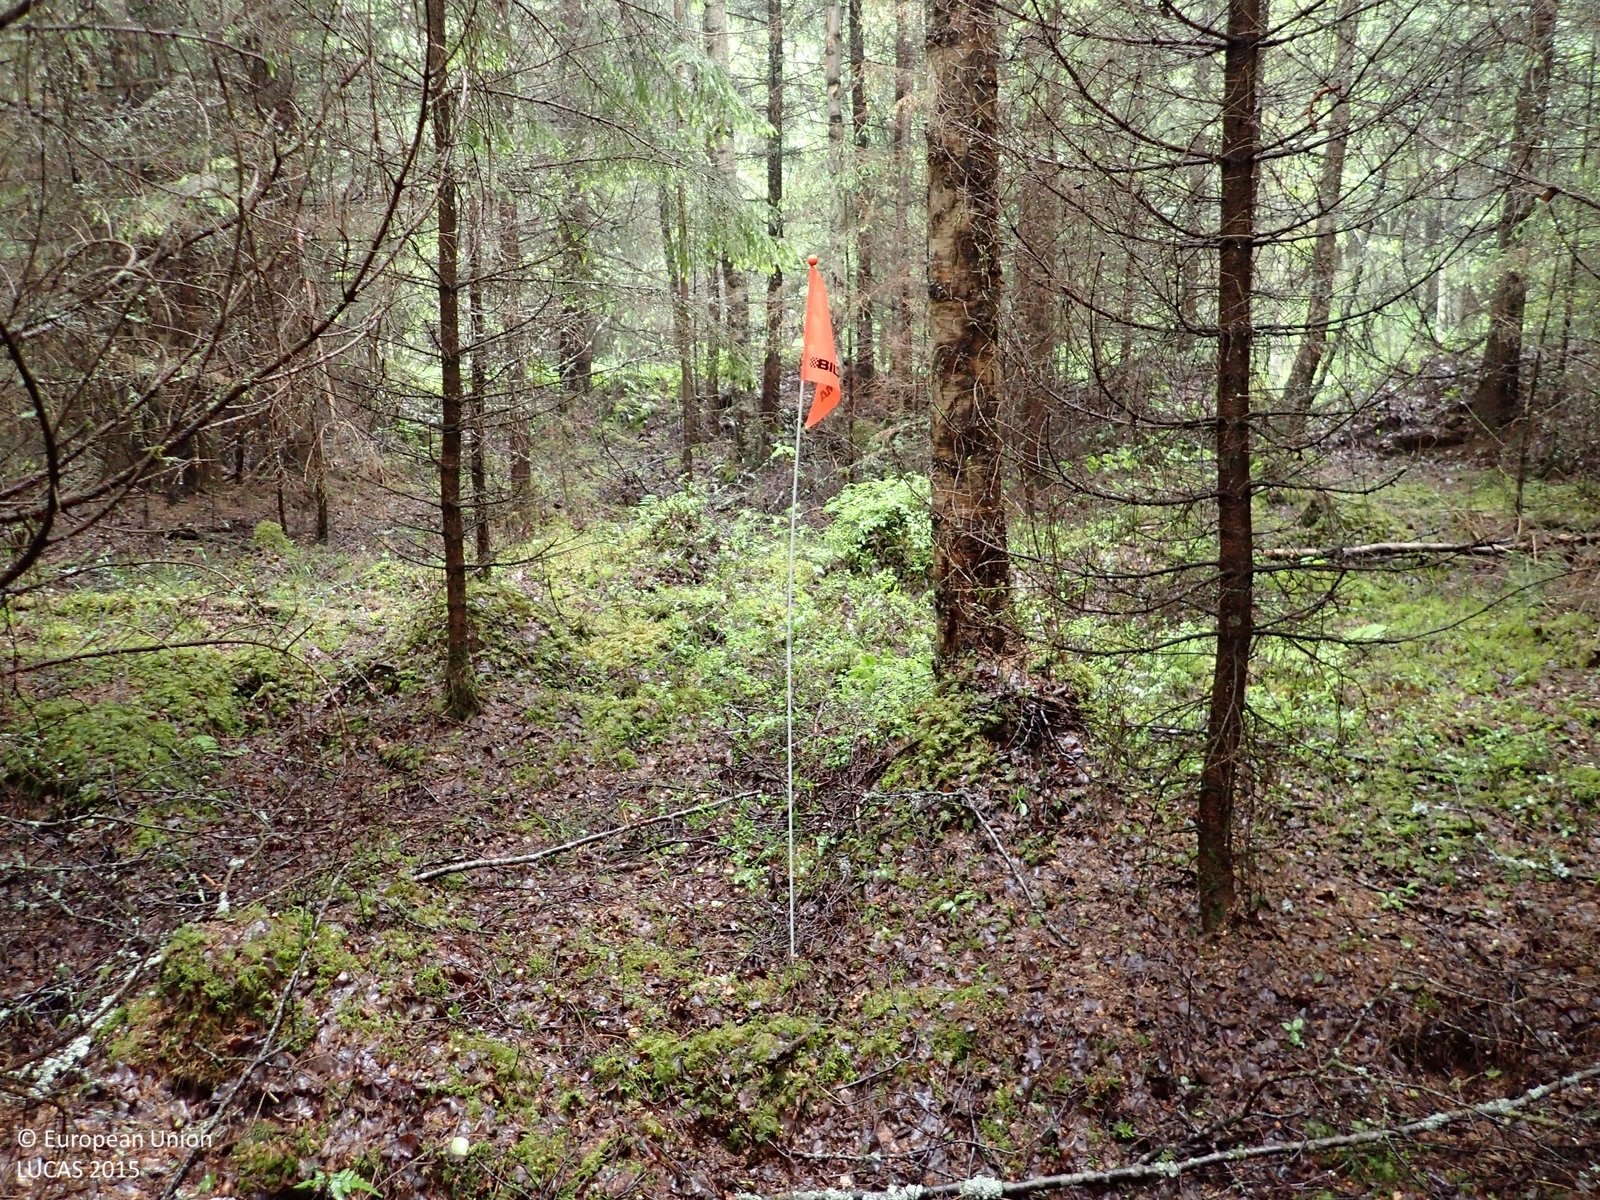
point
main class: Woodland
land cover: Spruce dominated mixed woodland
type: boreal forest
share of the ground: > 75 %
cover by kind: coniferous forest trees 65 %, broadleaved forest trees 25 %, shrubs 5 %, herbaceous plants 5 %
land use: Forestry
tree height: > 5 m
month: June
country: FI
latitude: 62.2938
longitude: 21.5554
